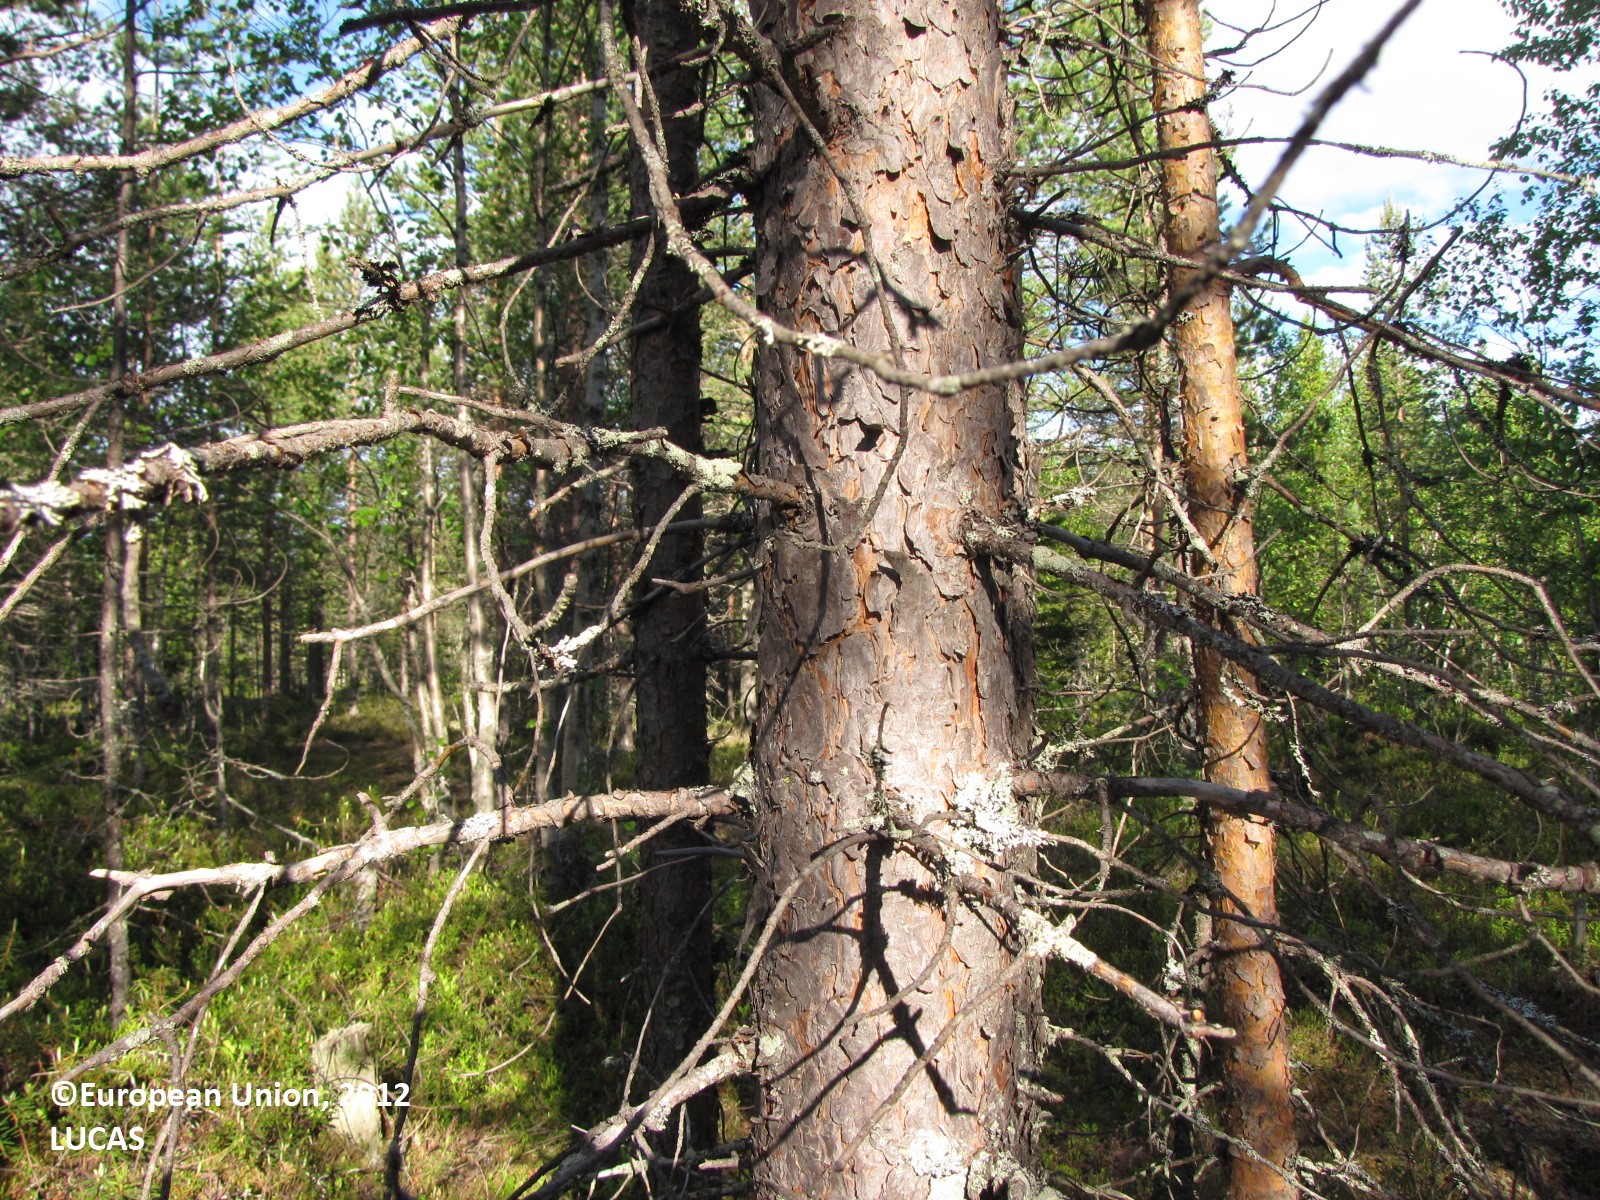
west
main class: Woodland
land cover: Pine dominated coniferous woodland
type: boreal forest
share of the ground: 50 - 75 %
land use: Forestry
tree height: > 5 m
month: June
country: FI
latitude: 66.2496
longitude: 24.3527
